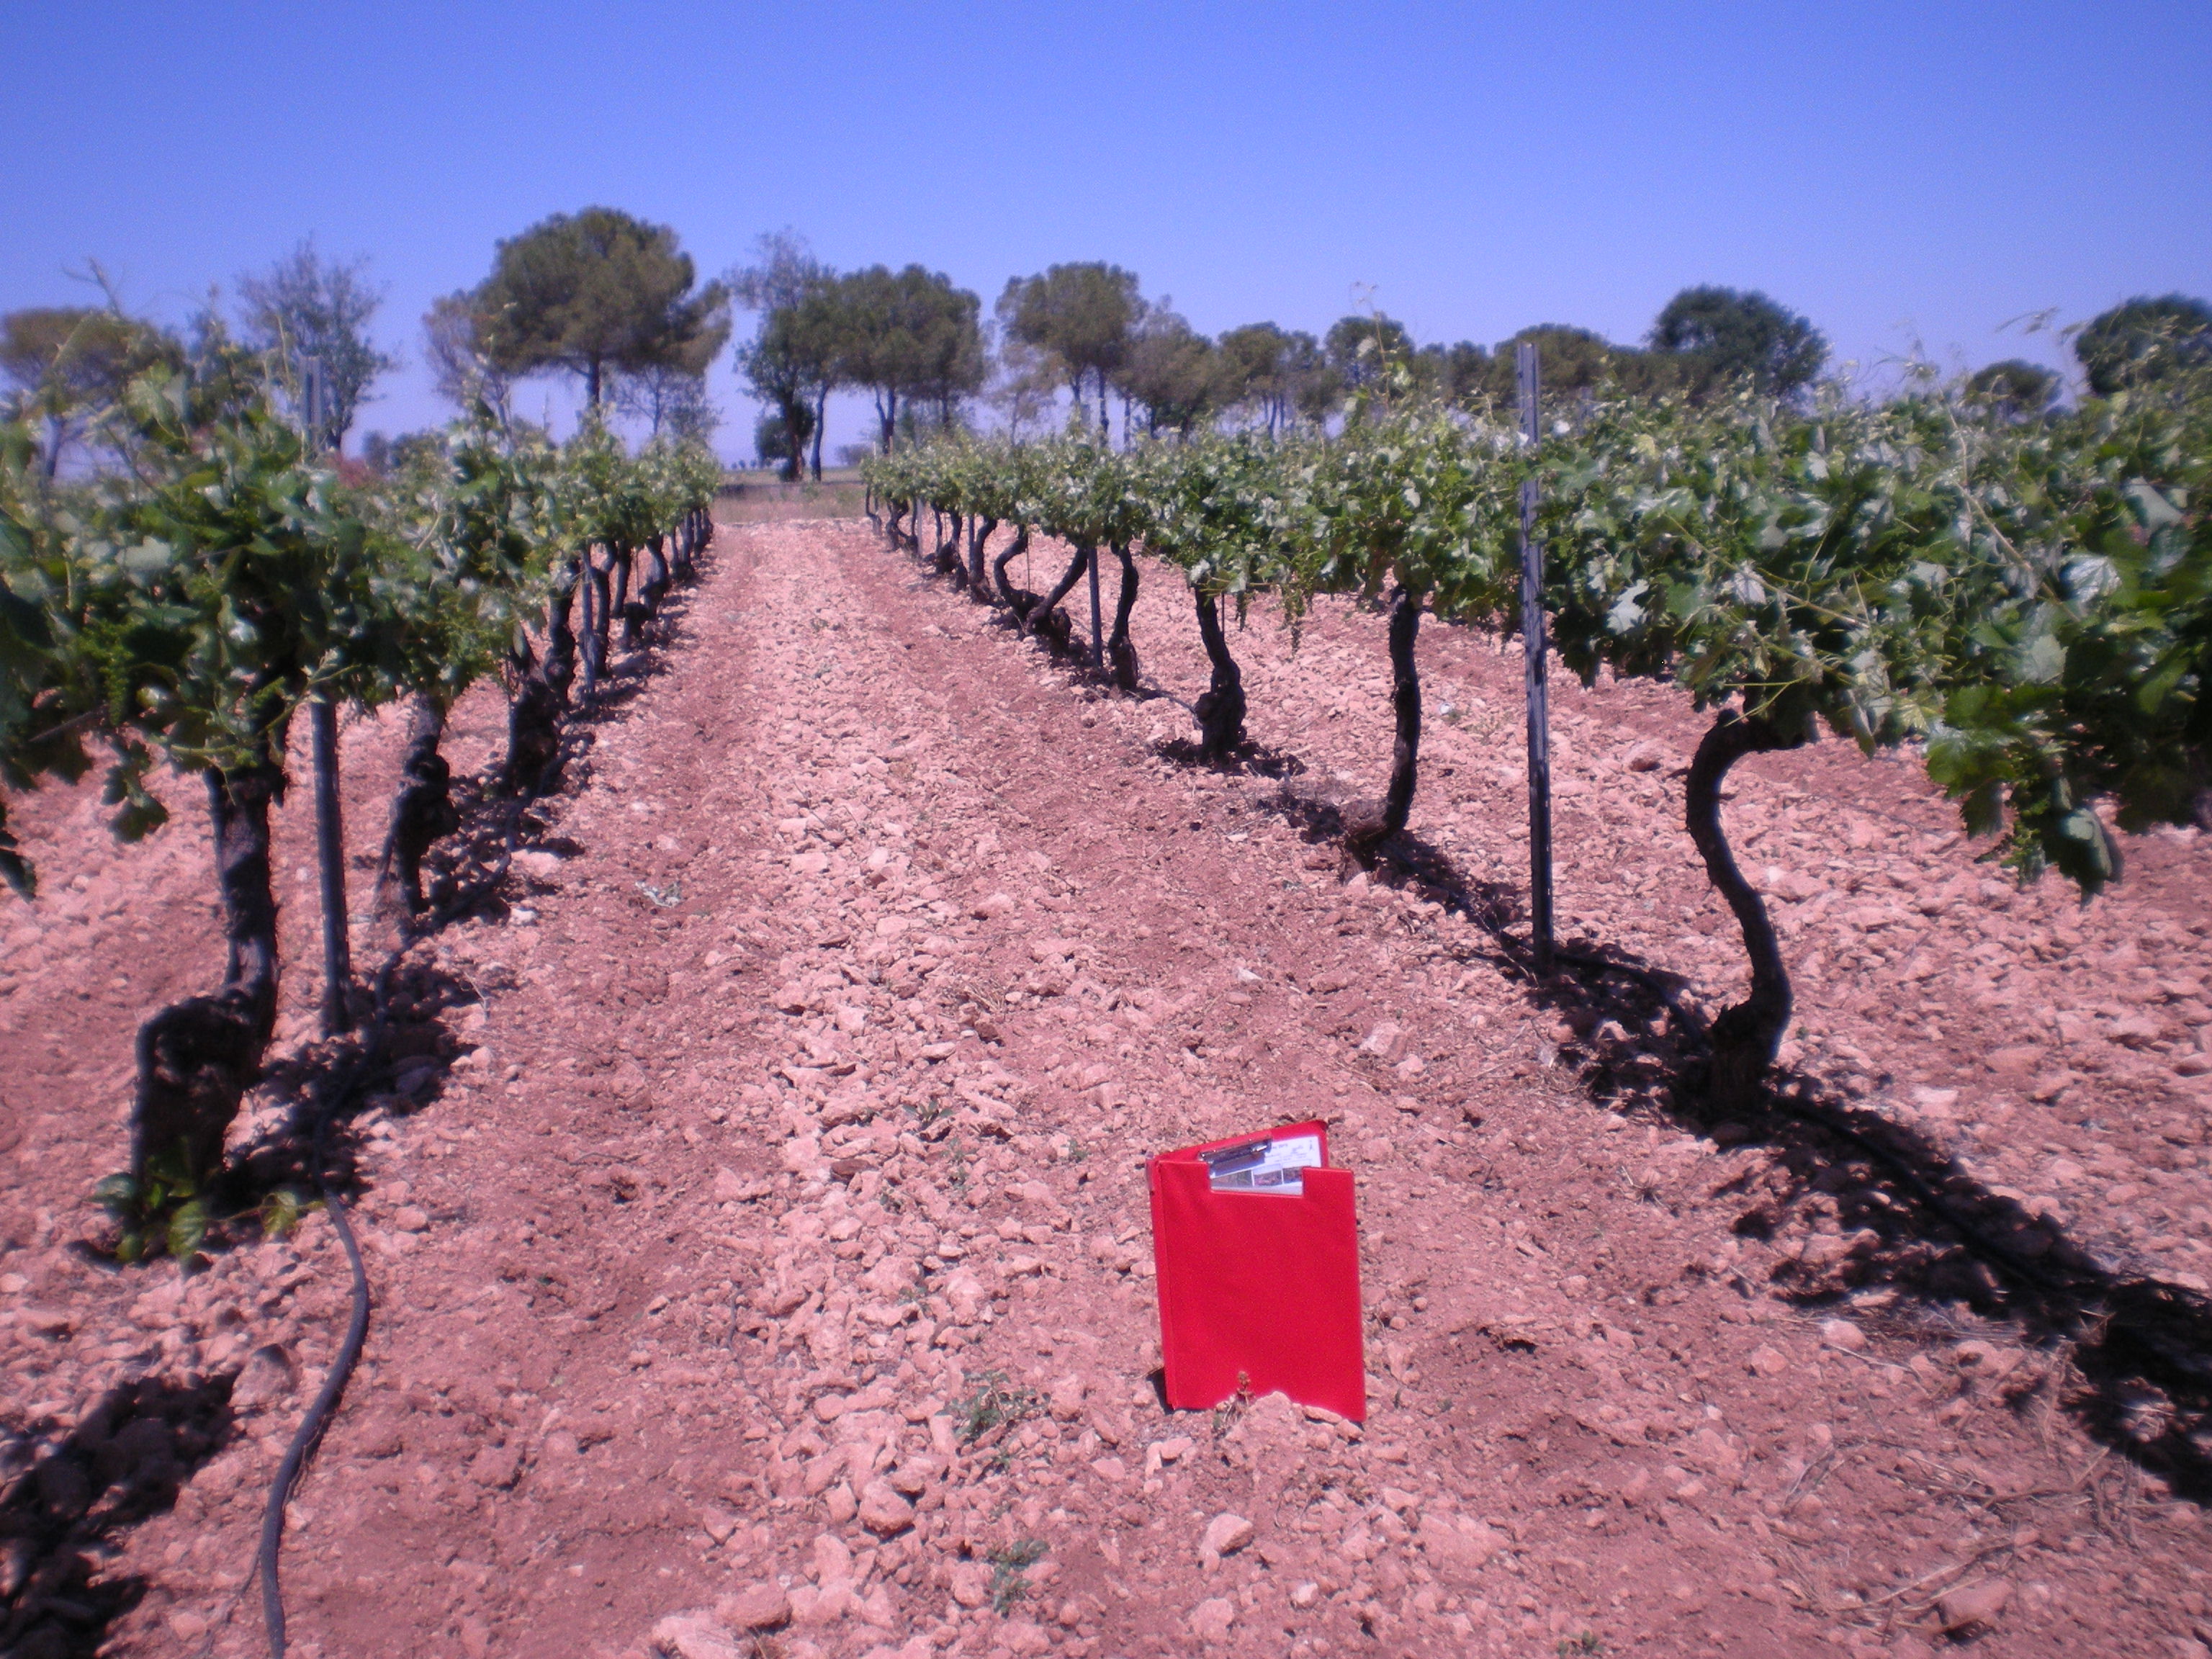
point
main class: Cropland
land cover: Vineyards
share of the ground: 10 - 25 %
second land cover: Other bare soil
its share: > 75 %
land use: Agriculture (excluding fallow land and kitchen gardens)
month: May
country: ES
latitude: 39.0902
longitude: -3.1118
